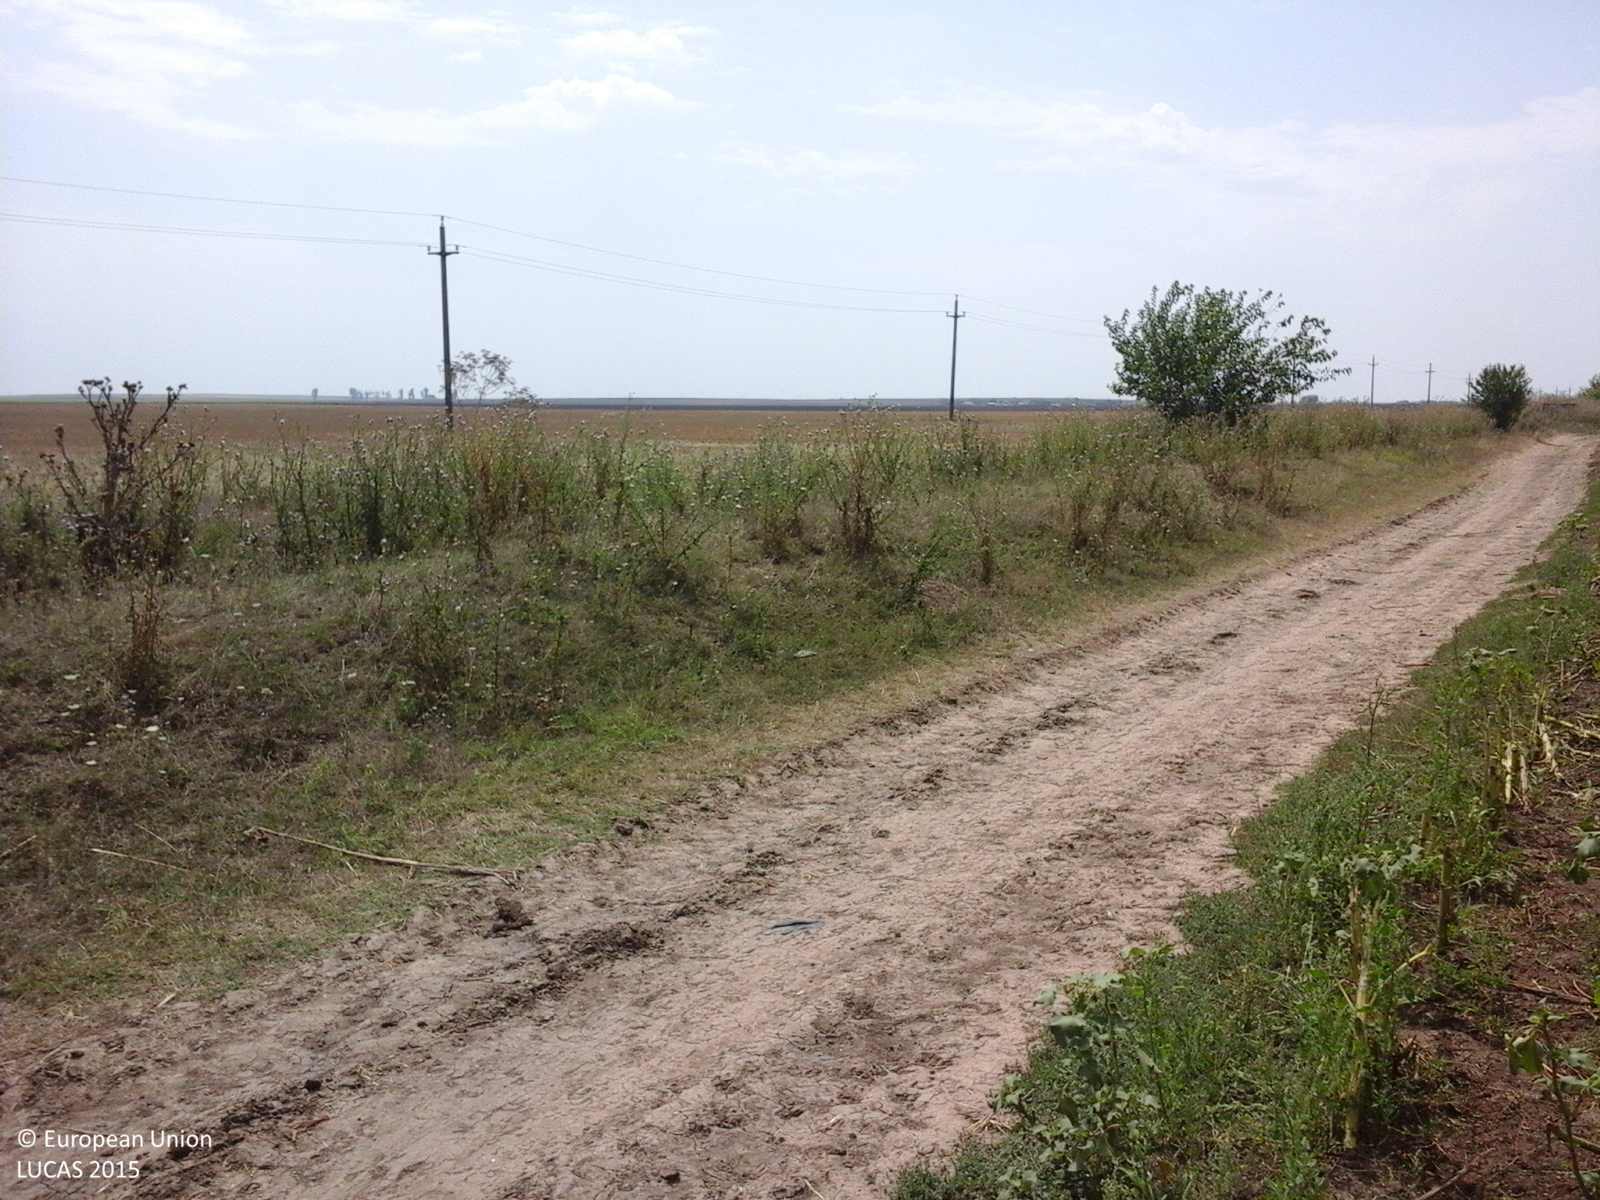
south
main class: Cropland
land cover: Sunflower
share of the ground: > 75 %
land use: Agriculture (excluding fallow land and kitchen gardens)
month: August
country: RO
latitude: 43.9447
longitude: 28.3913
